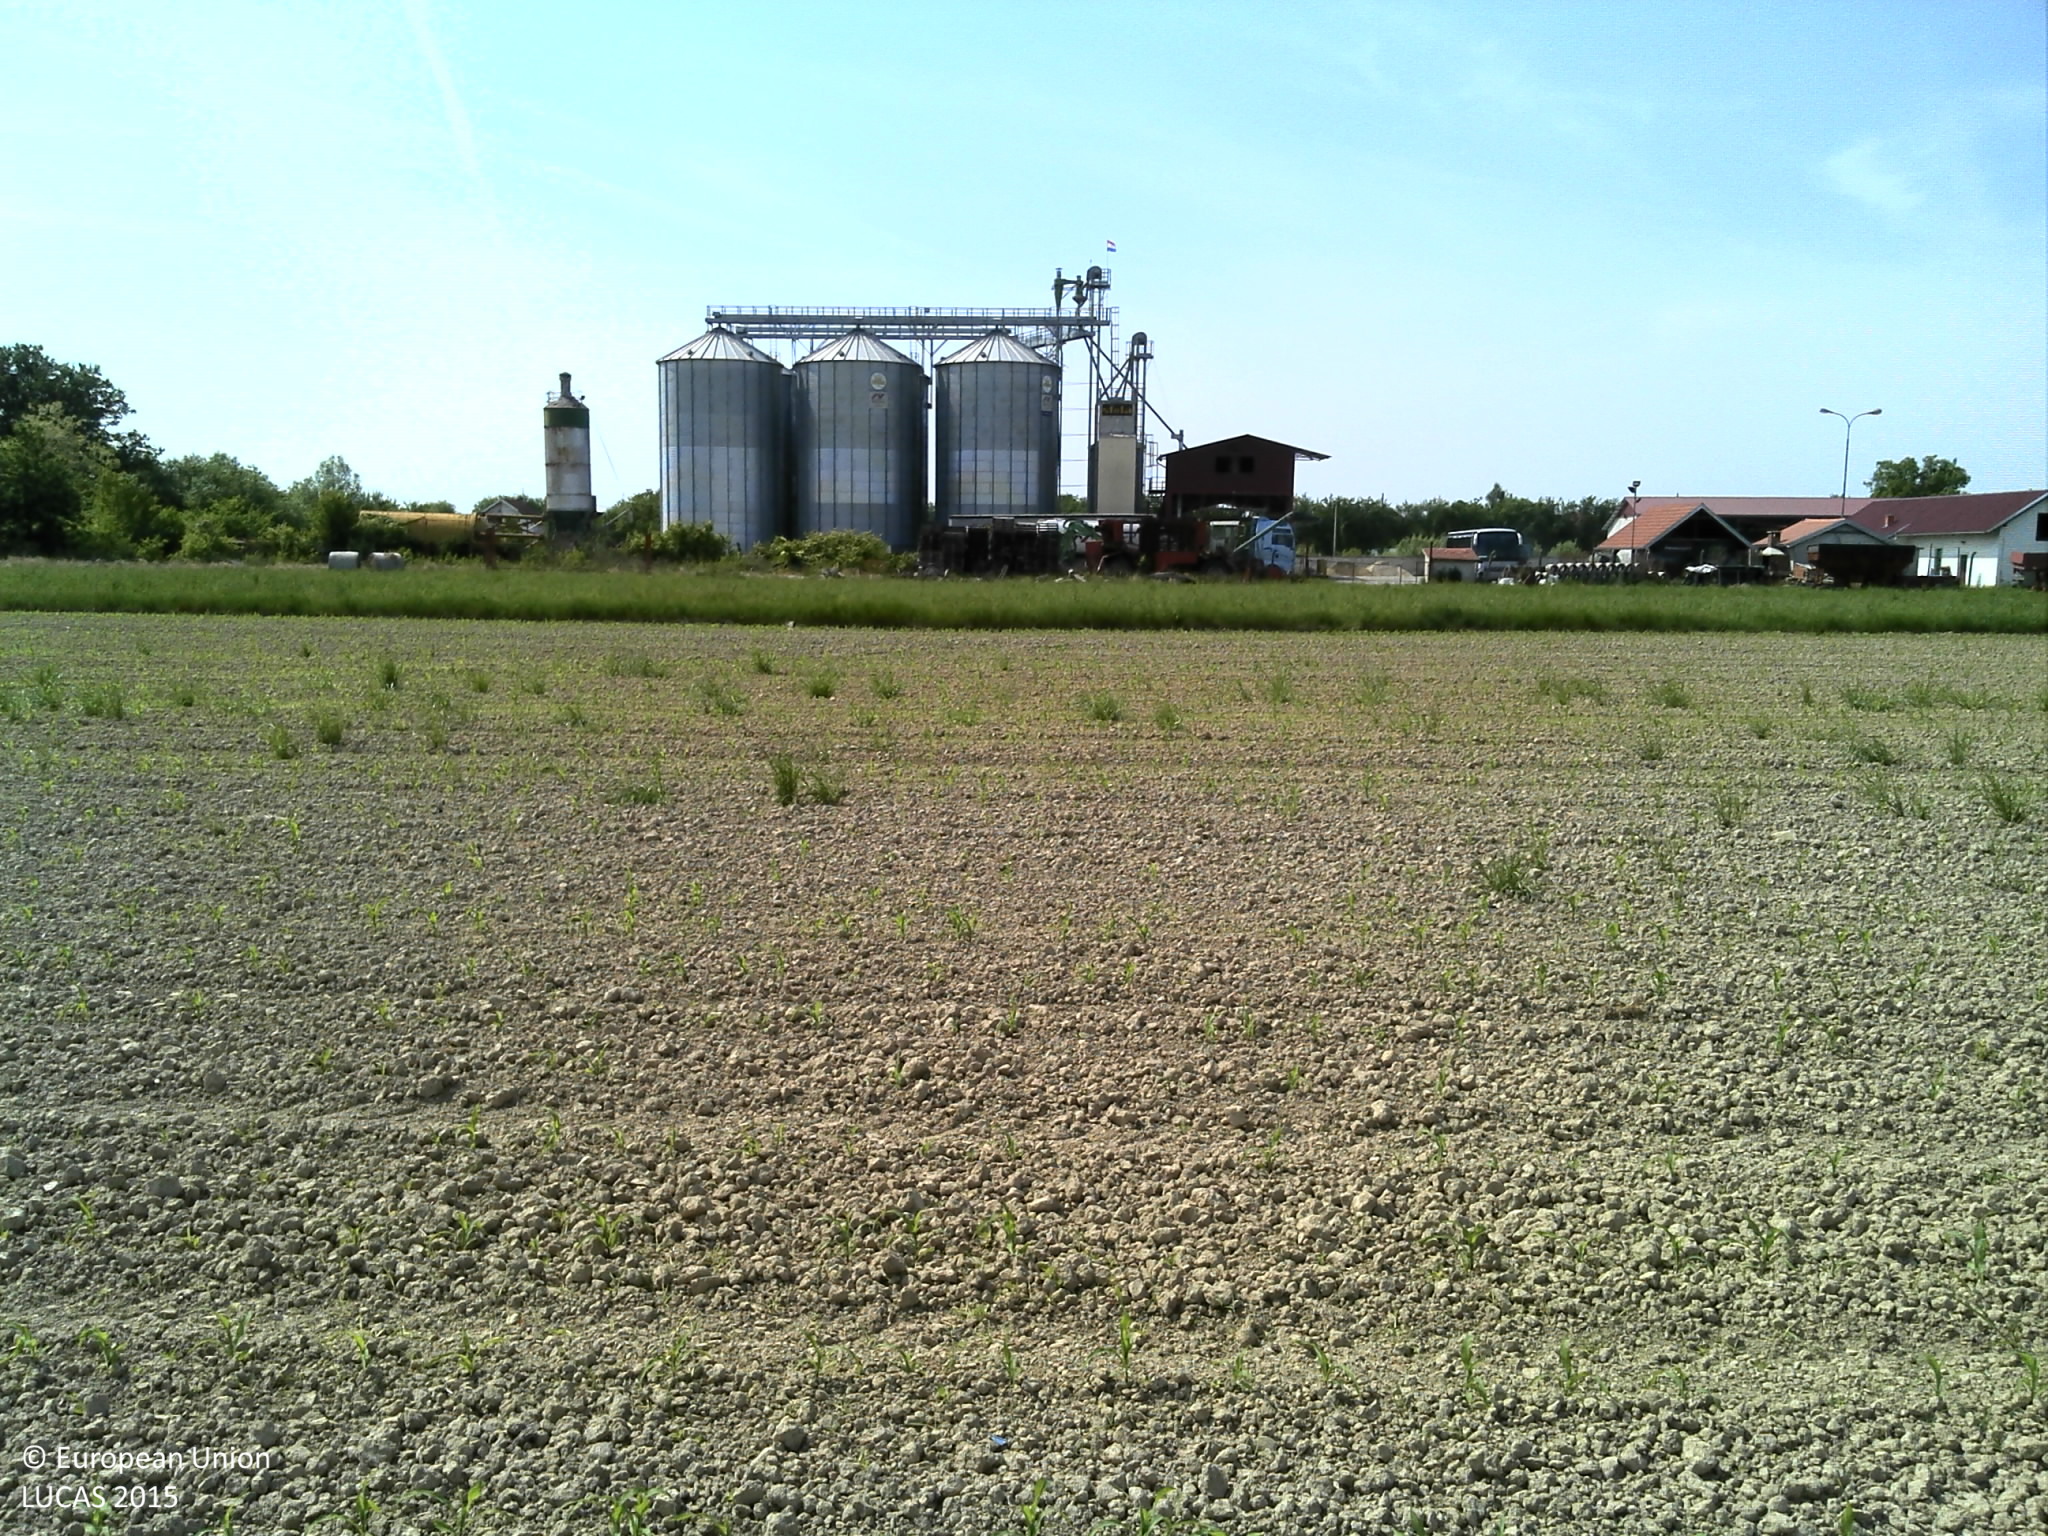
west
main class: Cropland
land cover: Maize
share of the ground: < 10 %
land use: Agriculture (excluding fallow land and kitchen gardens)
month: May
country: HR
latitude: 45.5757
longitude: 18.0649
